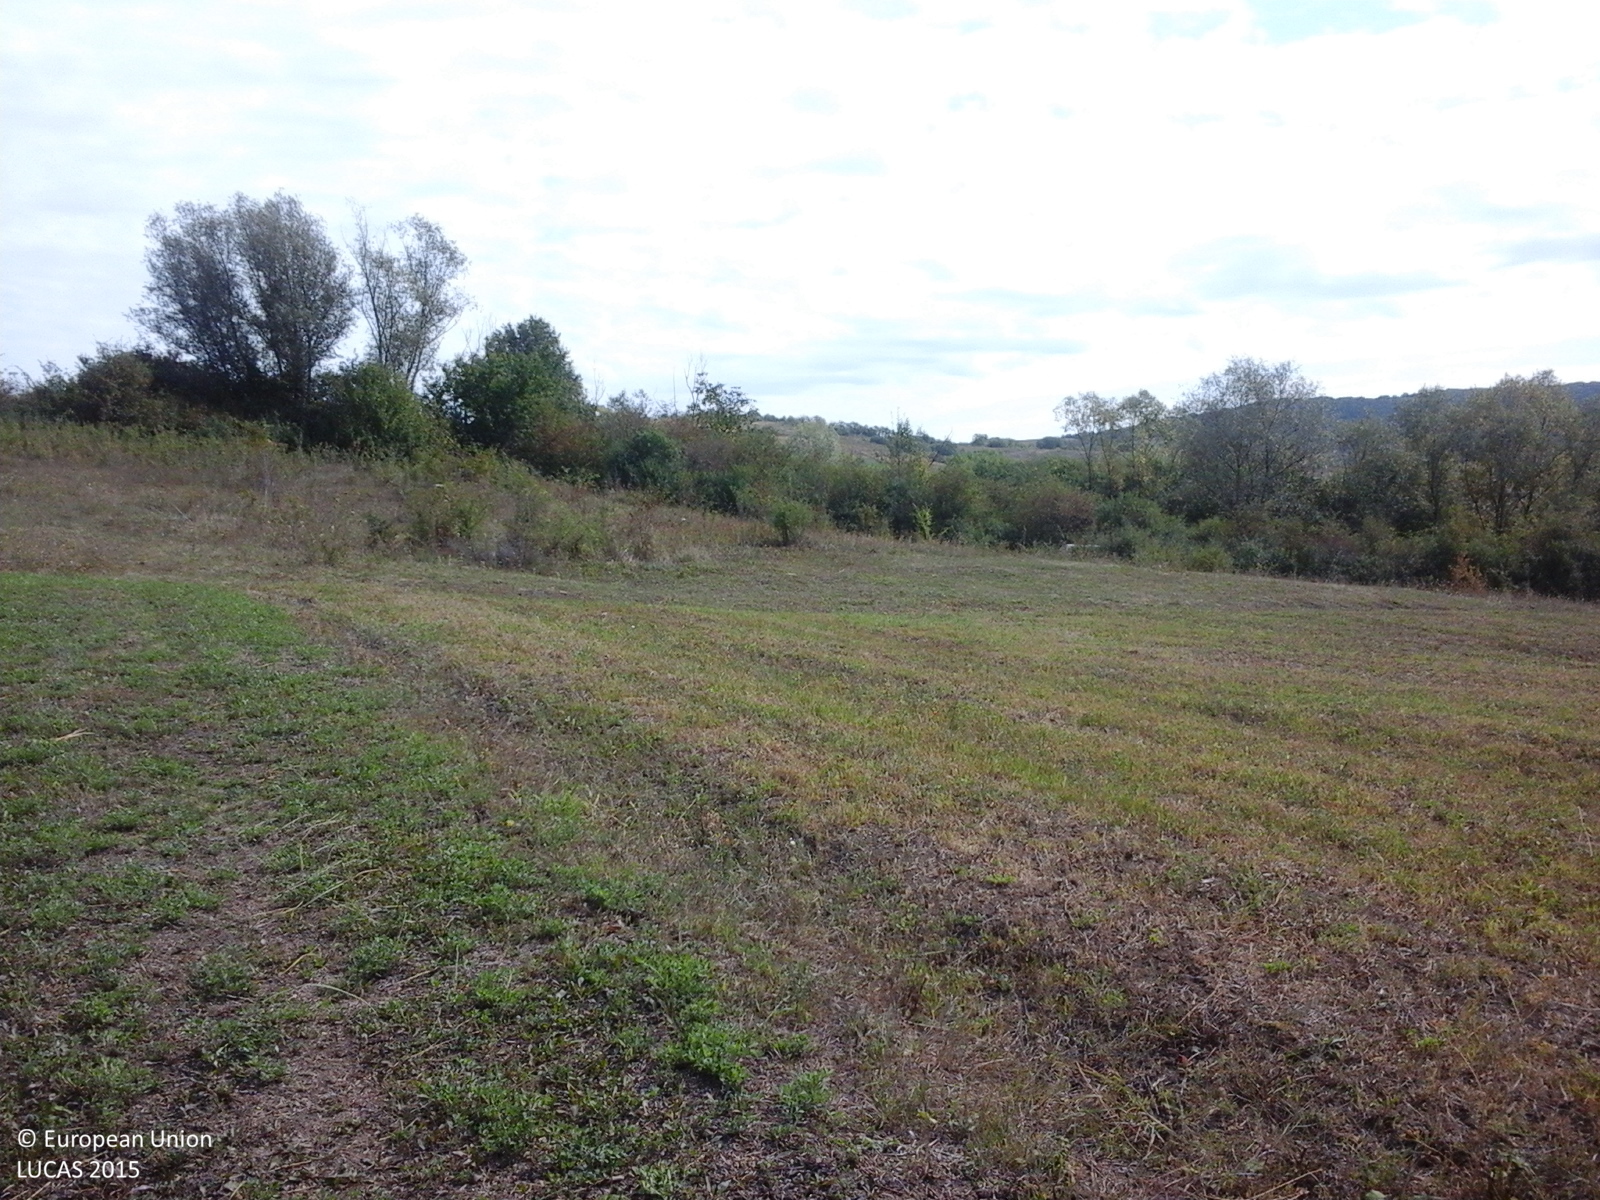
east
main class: Cropland
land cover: Lucerne
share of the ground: > 75 %
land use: Agriculture (excluding fallow land and kitchen gardens)
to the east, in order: Lucerne; Grassland with sparse tree/shrub cover; Tracks; Broadleaved woodland; Grassland with sparse tree/shrub cover; Grassland without tree/shrub cover; Shrubland without tree cover; Grassland with sparse tree/shrub cover
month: September
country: RO
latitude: 47.3510
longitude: 23.2131
